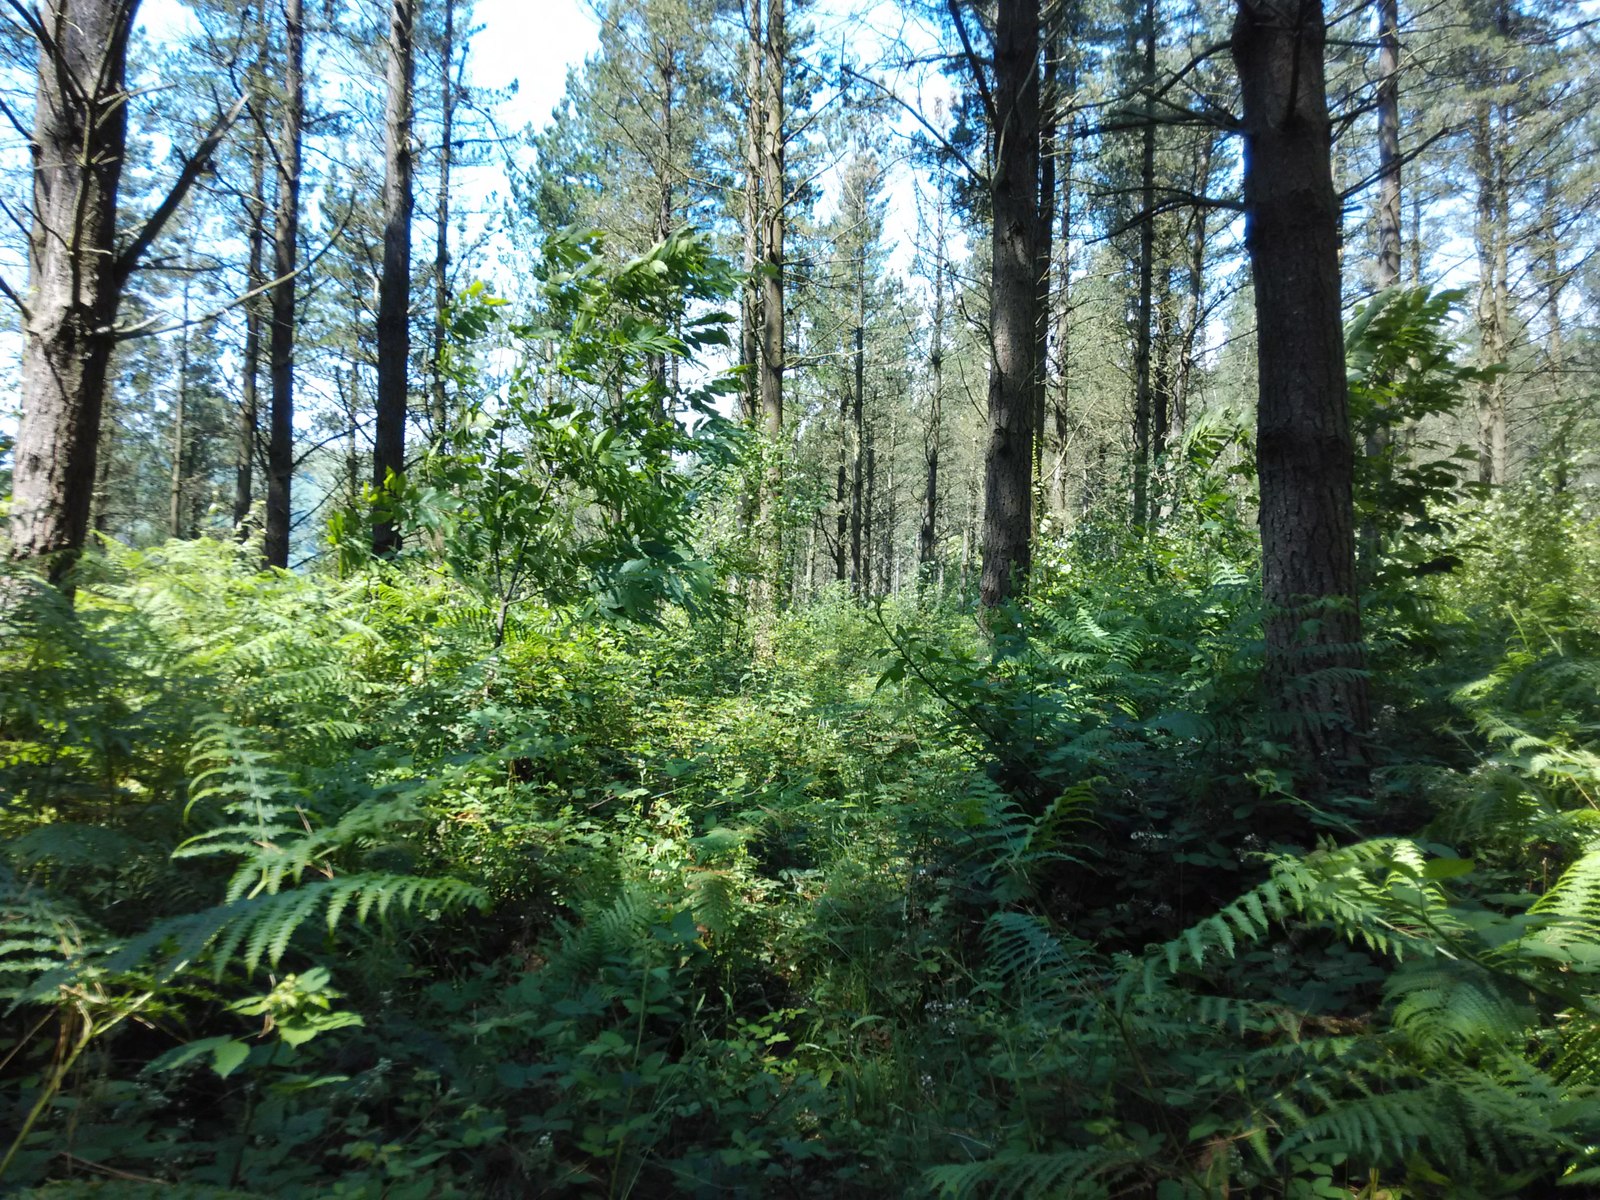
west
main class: Woodland
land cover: Pine dominated coniferous woodland
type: exotic forest
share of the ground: > 75 %
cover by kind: coniferous forest trees 100 %
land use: Forestry
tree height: > 5 m
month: July
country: ES
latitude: 43.1438
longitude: -2.2831
